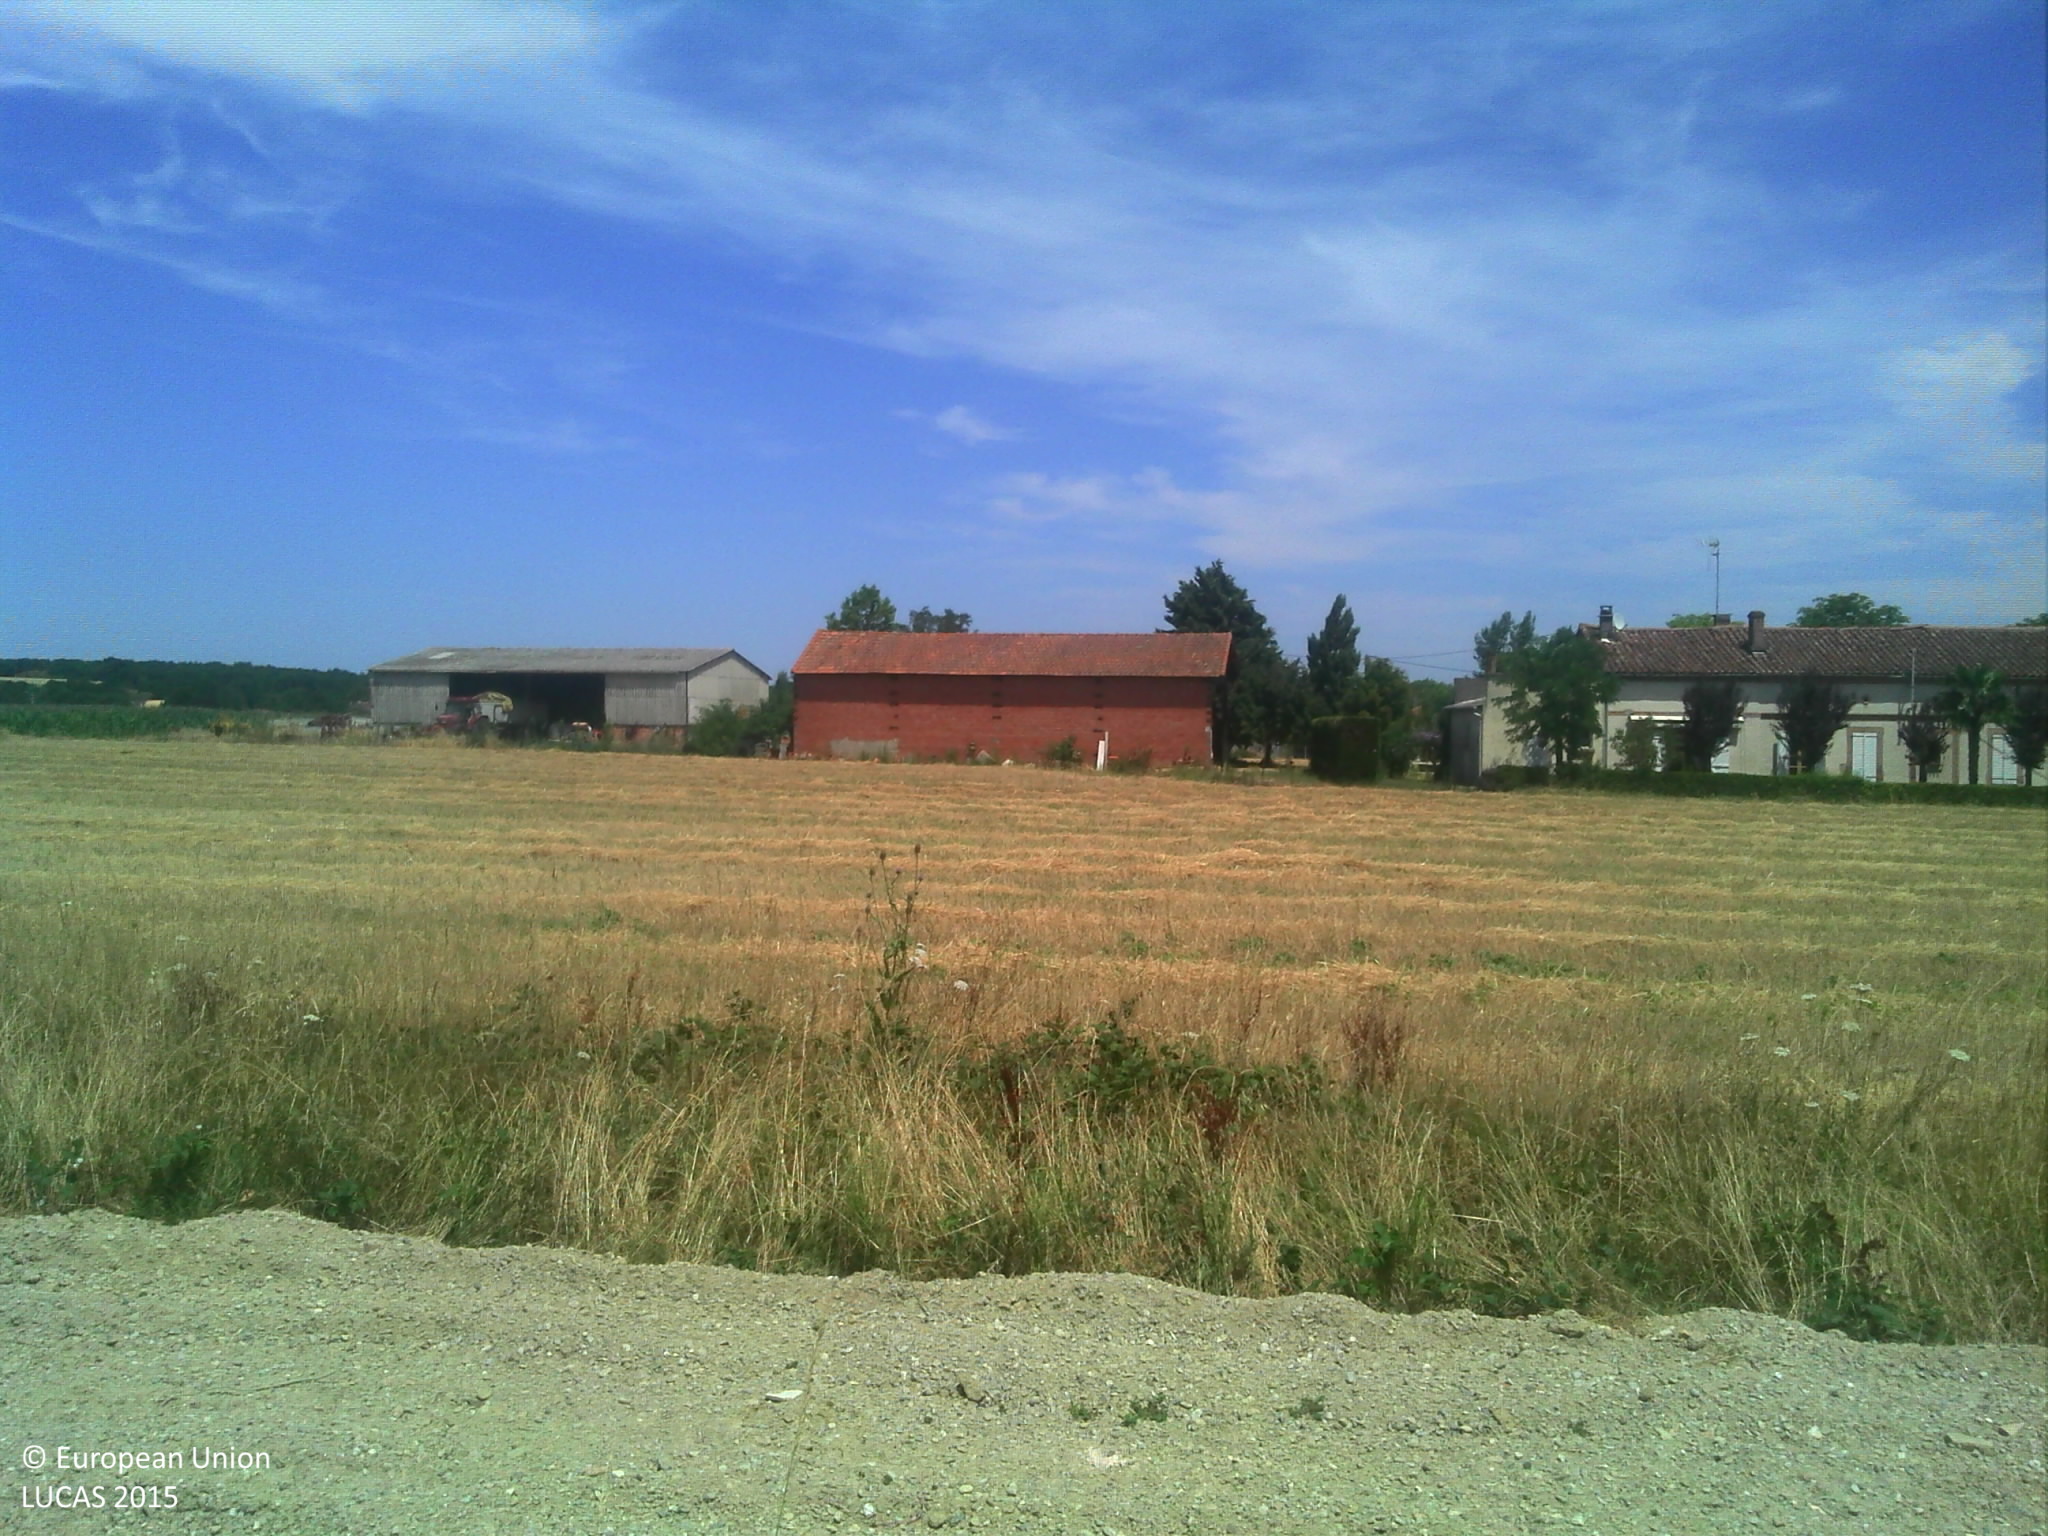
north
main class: Grassland
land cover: Spontaneously vegetated surfaces
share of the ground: > 75 %
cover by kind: herbaceous plants 80 %, consolidated bare surface 20 %
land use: Residential
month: July
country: FR
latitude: 43.4103
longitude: 1.3712
